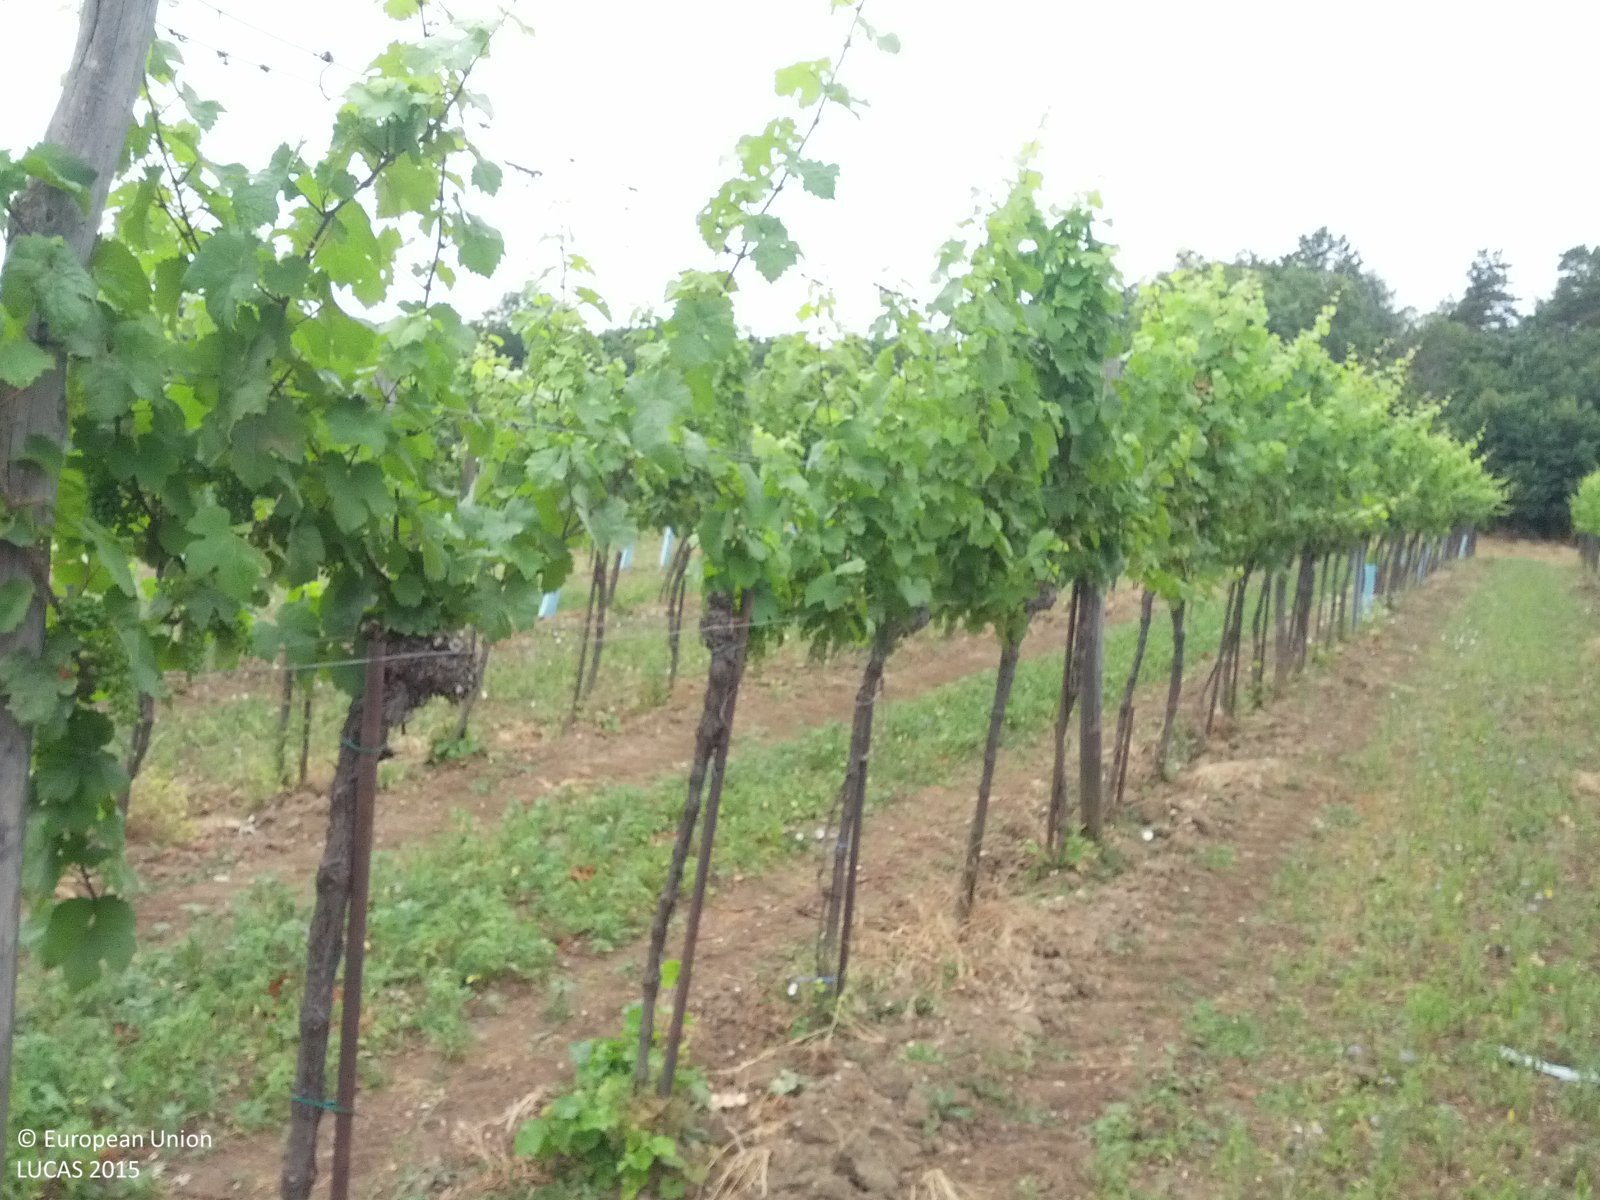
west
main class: Cropland
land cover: Vineyards
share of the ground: 25 - 50 %
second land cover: Grassland without tree/shrub cover
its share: 50 - 75 %
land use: Agriculture (excluding fallow land and kitchen gardens)
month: July
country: AT
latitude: 48.7460
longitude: 16.6300
